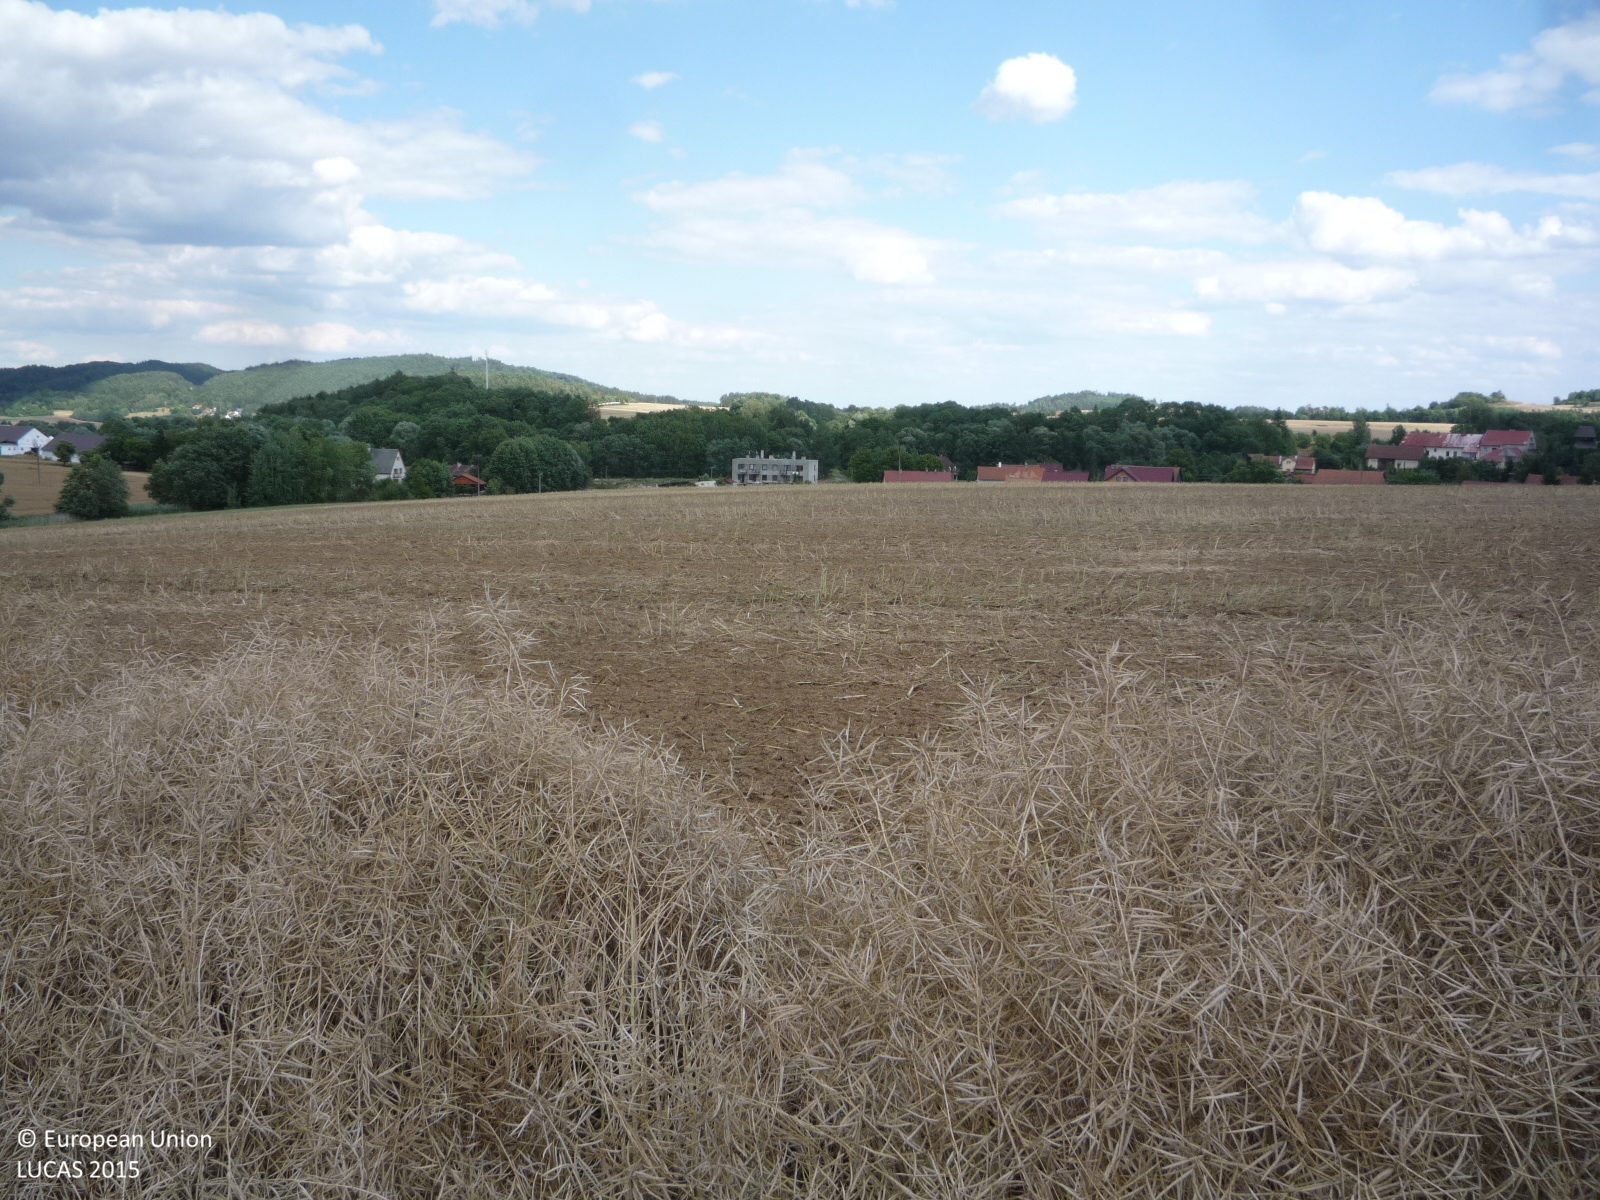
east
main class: Cropland
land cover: Rape and turnip rape
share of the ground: > 75 %
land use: Agriculture (excluding fallow land and kitchen gardens)
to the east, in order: Rape and turnip rape
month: July
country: CZ
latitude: 50.4607
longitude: 15.2295
